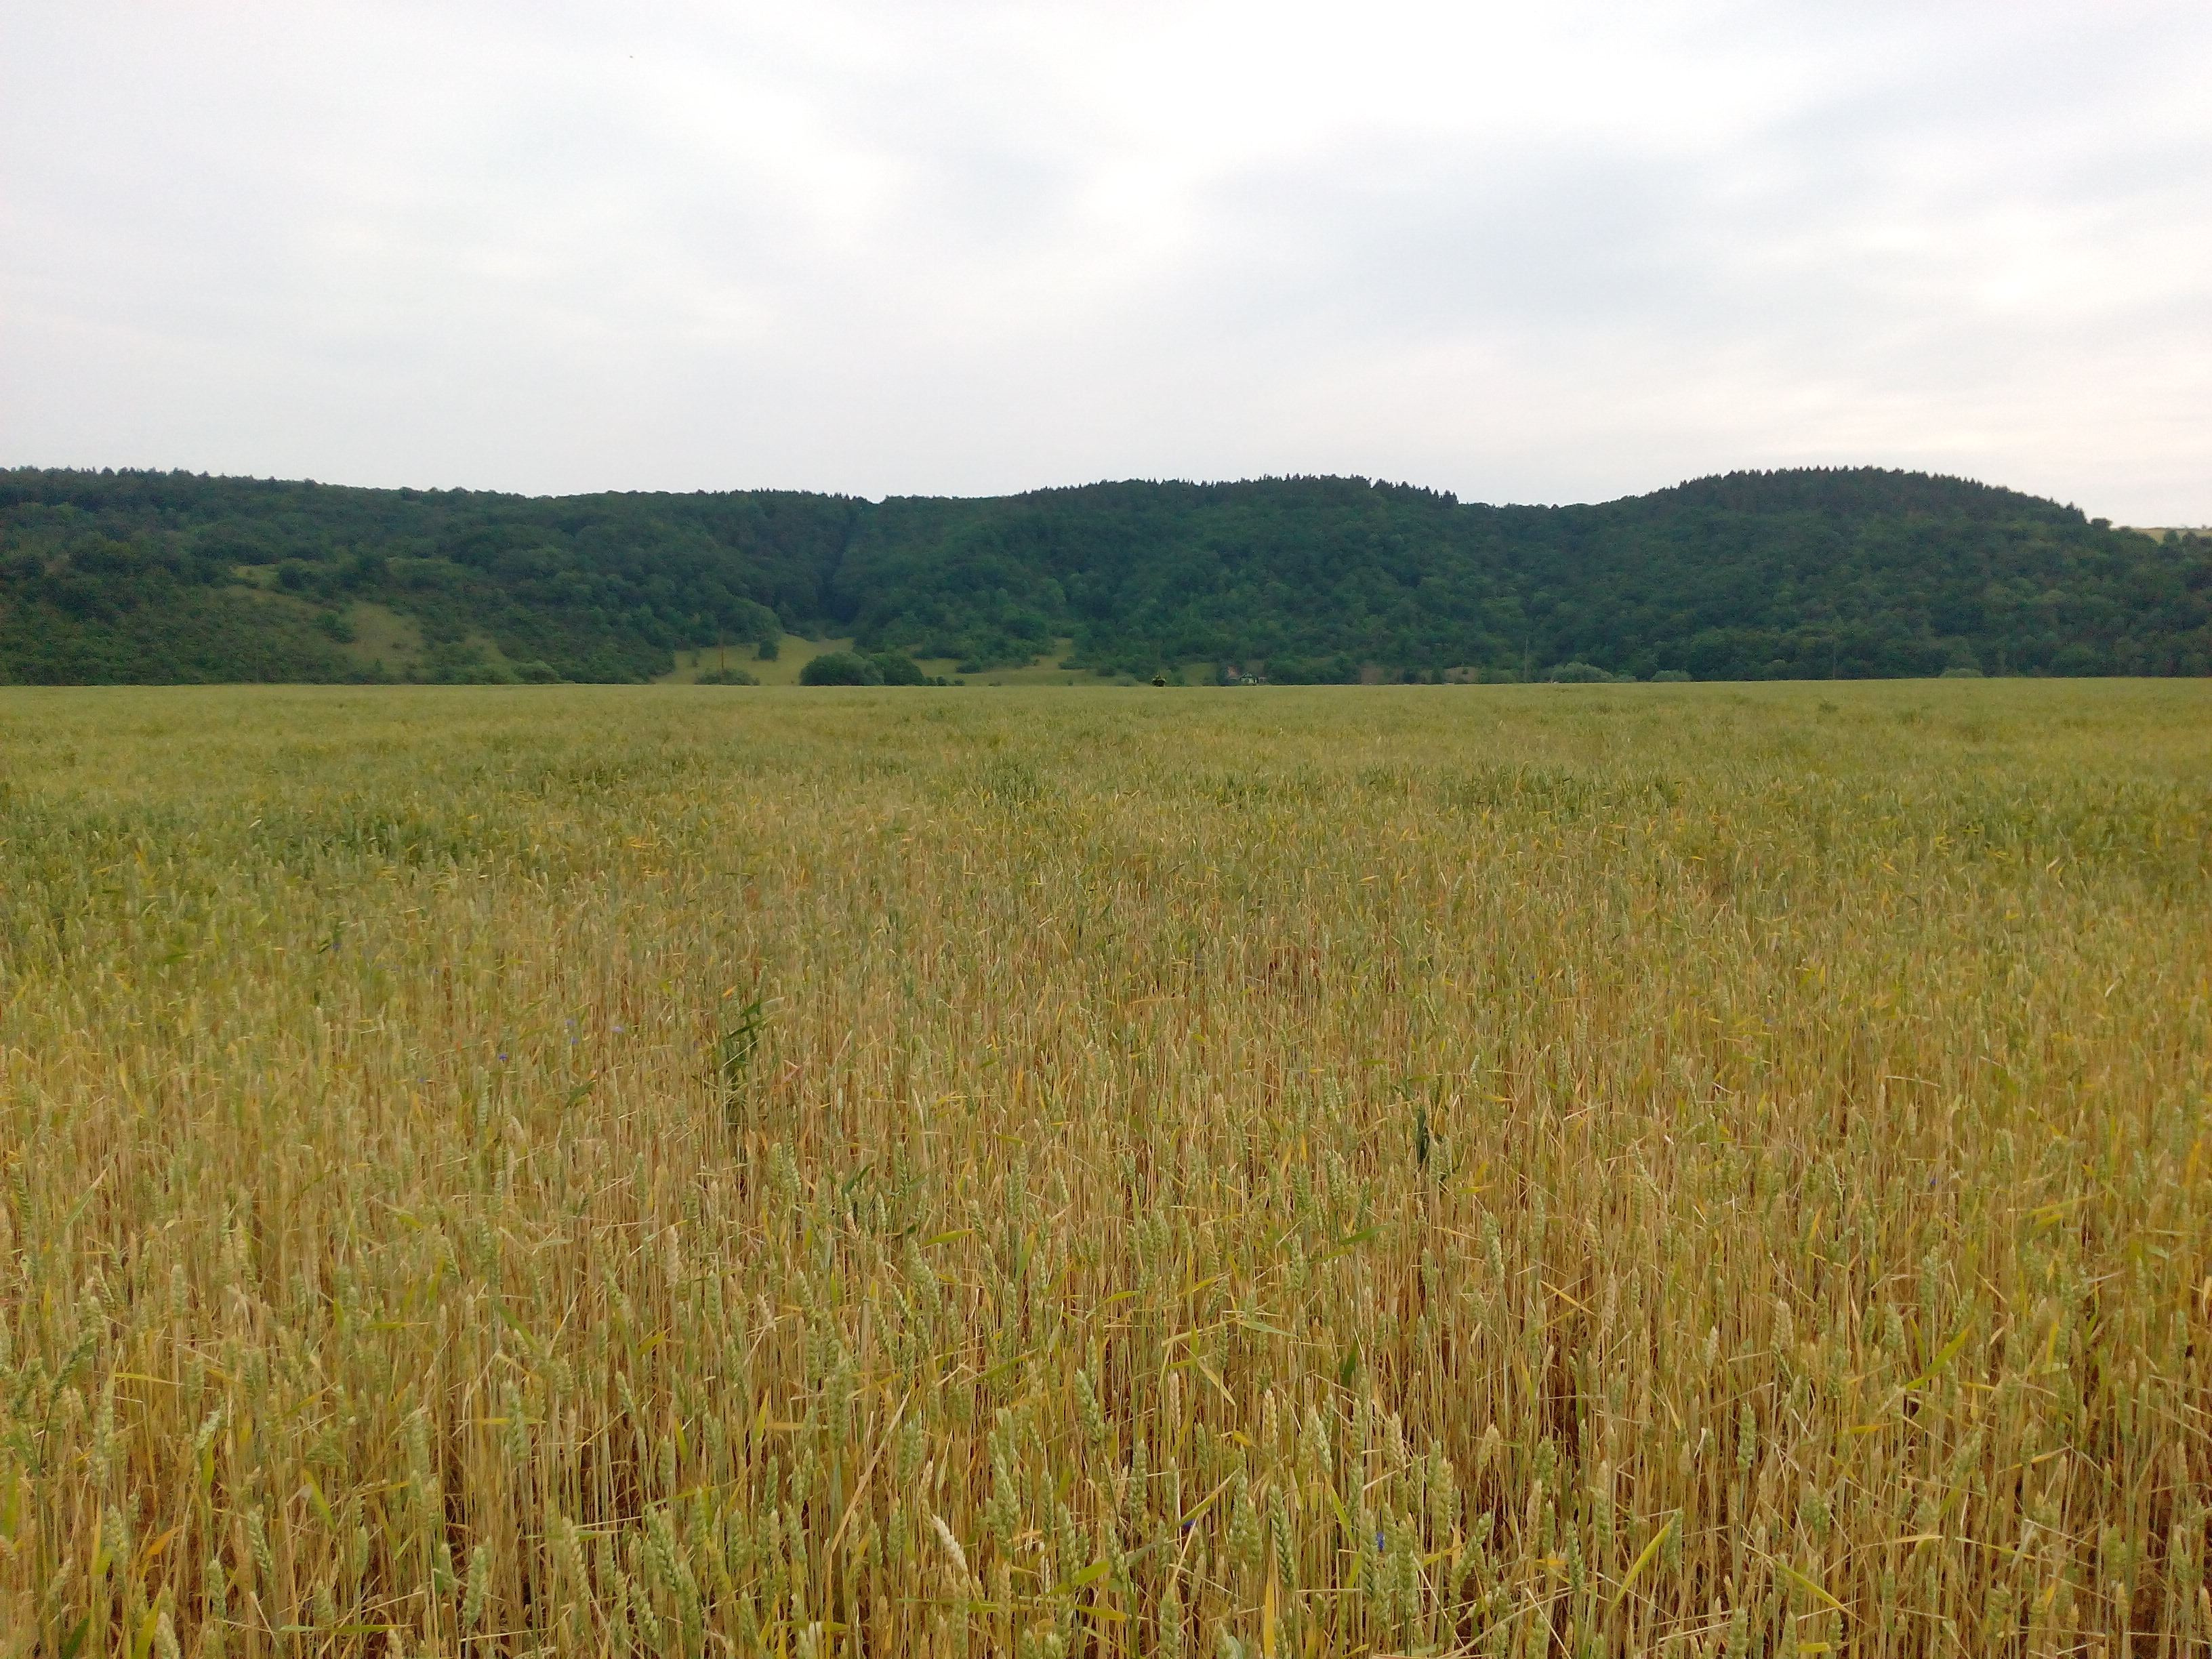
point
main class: Cropland
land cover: Common wheat
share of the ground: > 75 %
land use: Agriculture (excluding fallow land and kitchen gardens)
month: June
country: DE
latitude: 51.3489
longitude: 10.9617
